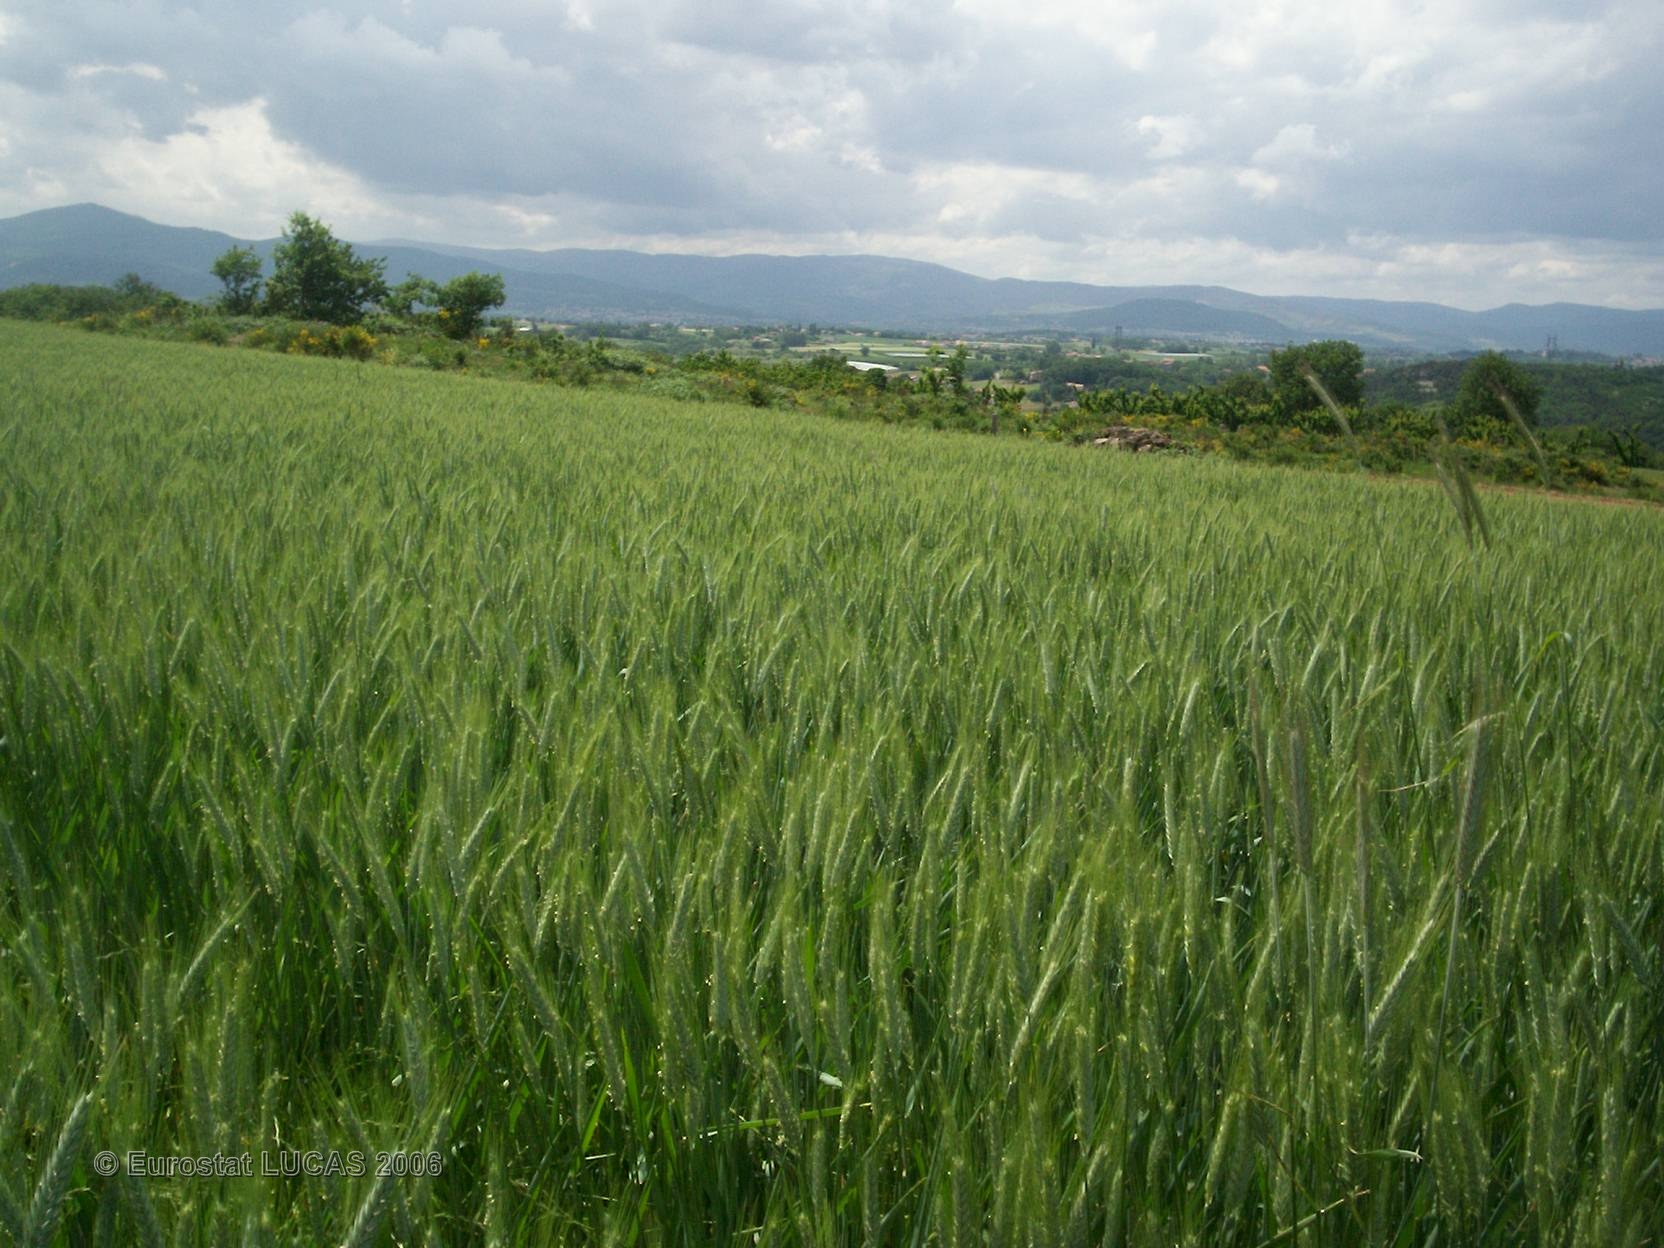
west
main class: Cropland
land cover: Triticale
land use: Agriculture (excluding fallow land and kitchen gardens)
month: May
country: FR
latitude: 45.2303
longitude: 4.7699
